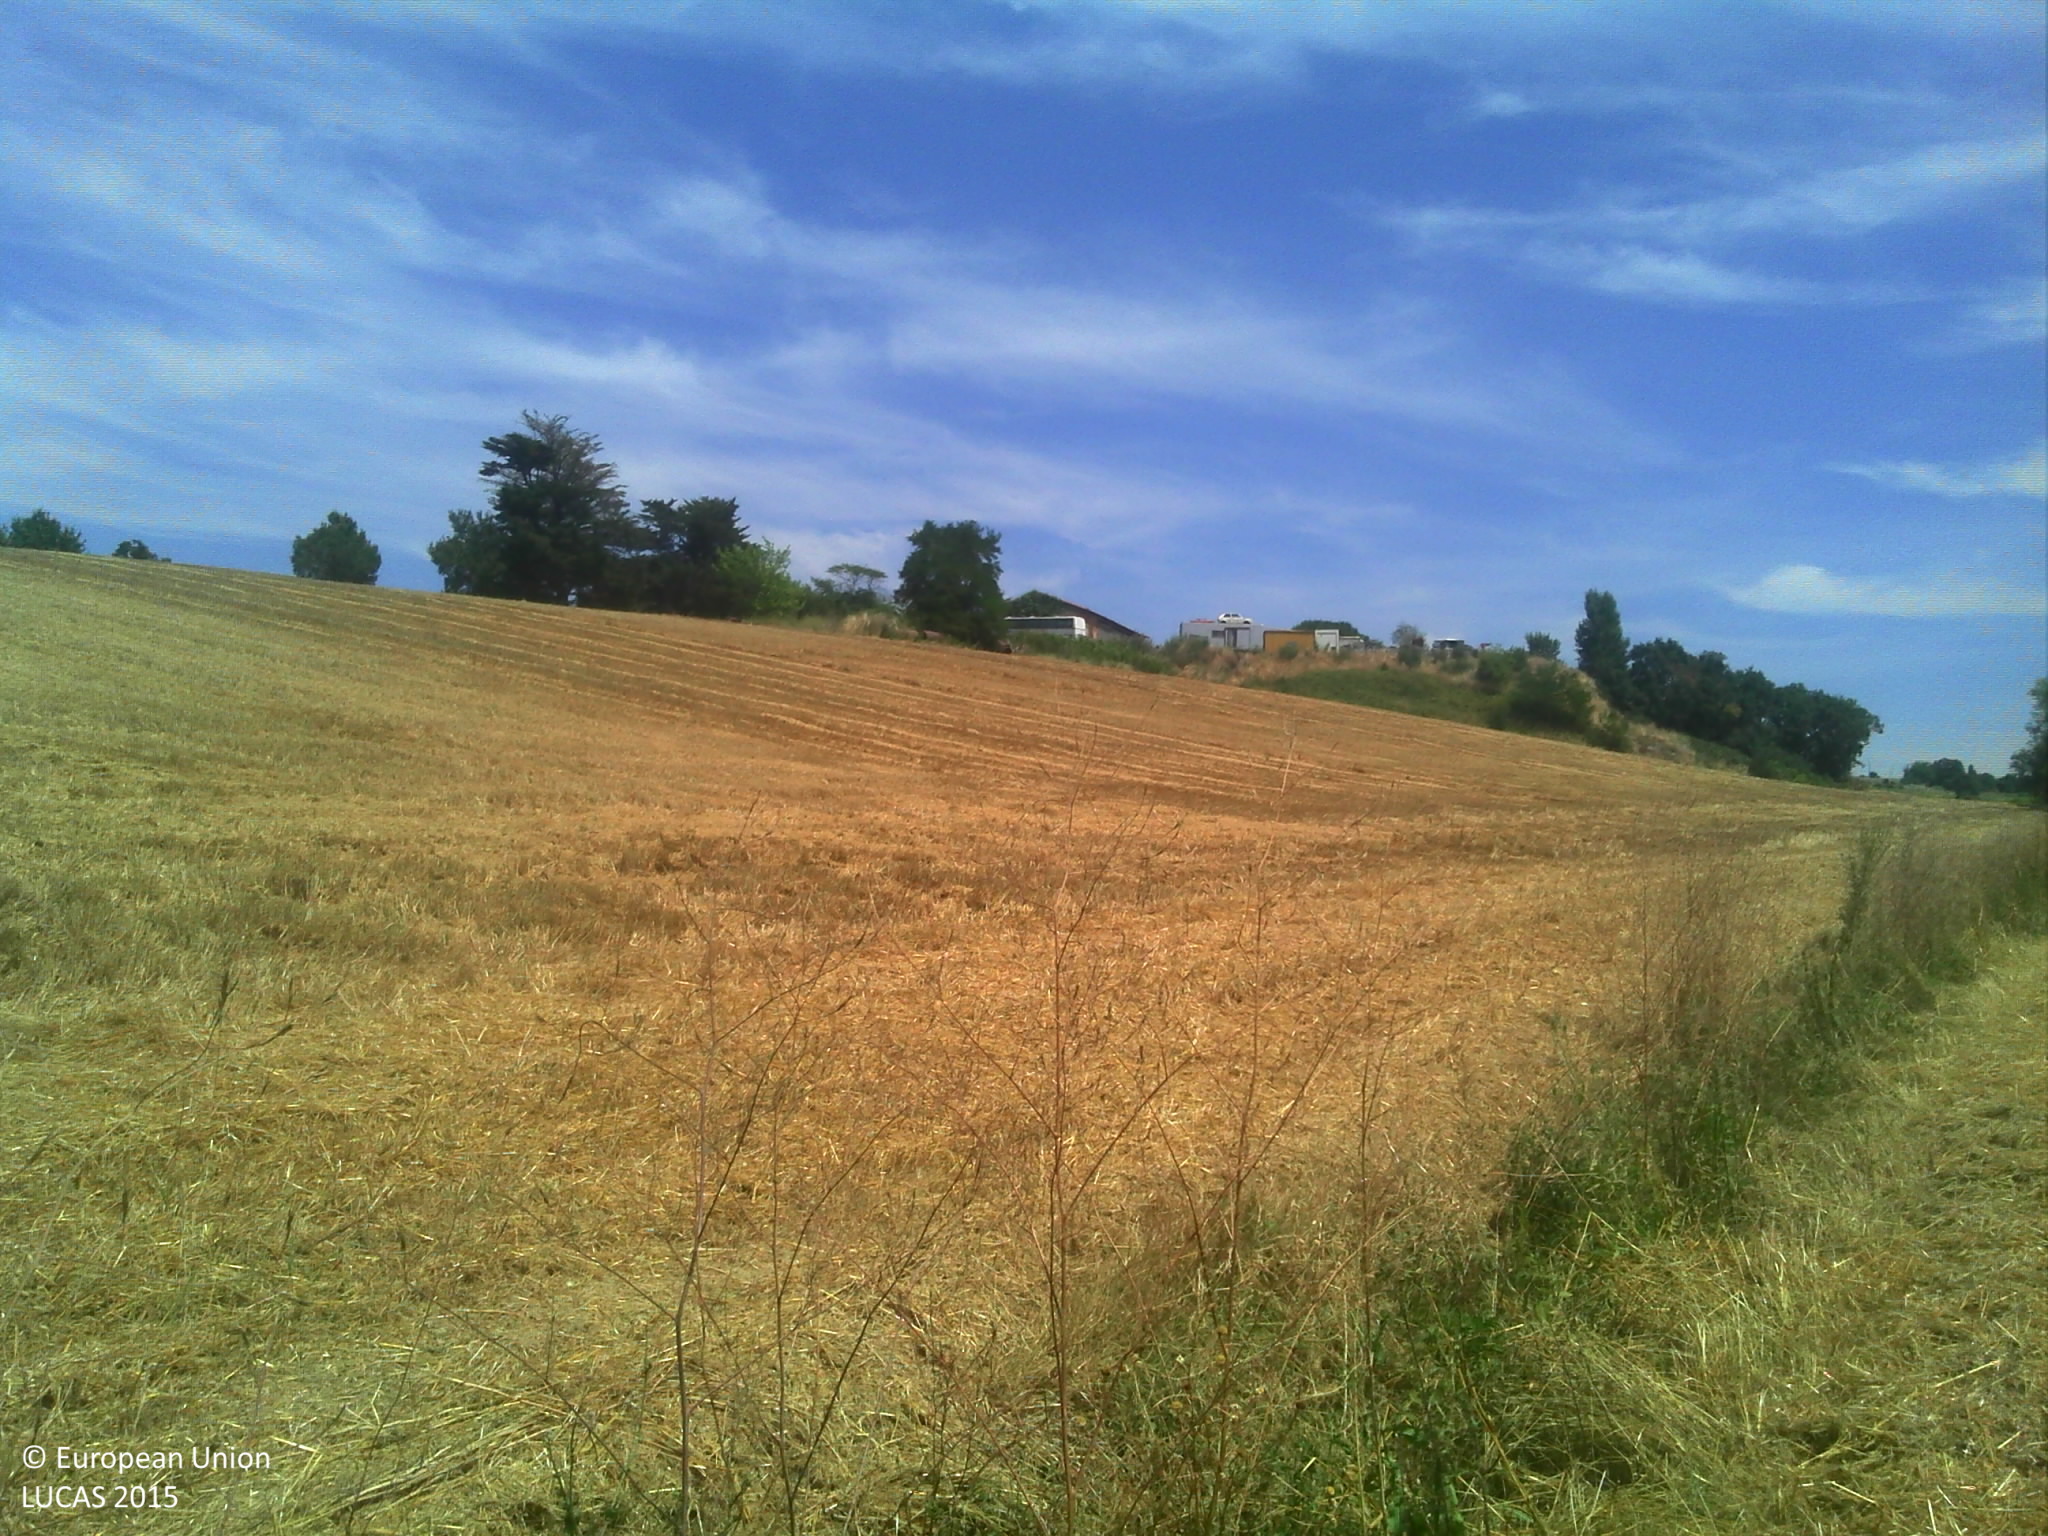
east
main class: Cropland
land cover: Common wheat
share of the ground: > 75 %
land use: Agriculture (excluding fallow land and kitchen gardens)
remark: Harvested field
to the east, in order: Common wheat; Ditches and canals; Common wheat; Spontaneously vegetated surfaces; Artificial constructions in urban areas
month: July
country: FR
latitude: 43.4523
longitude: 1.4395
